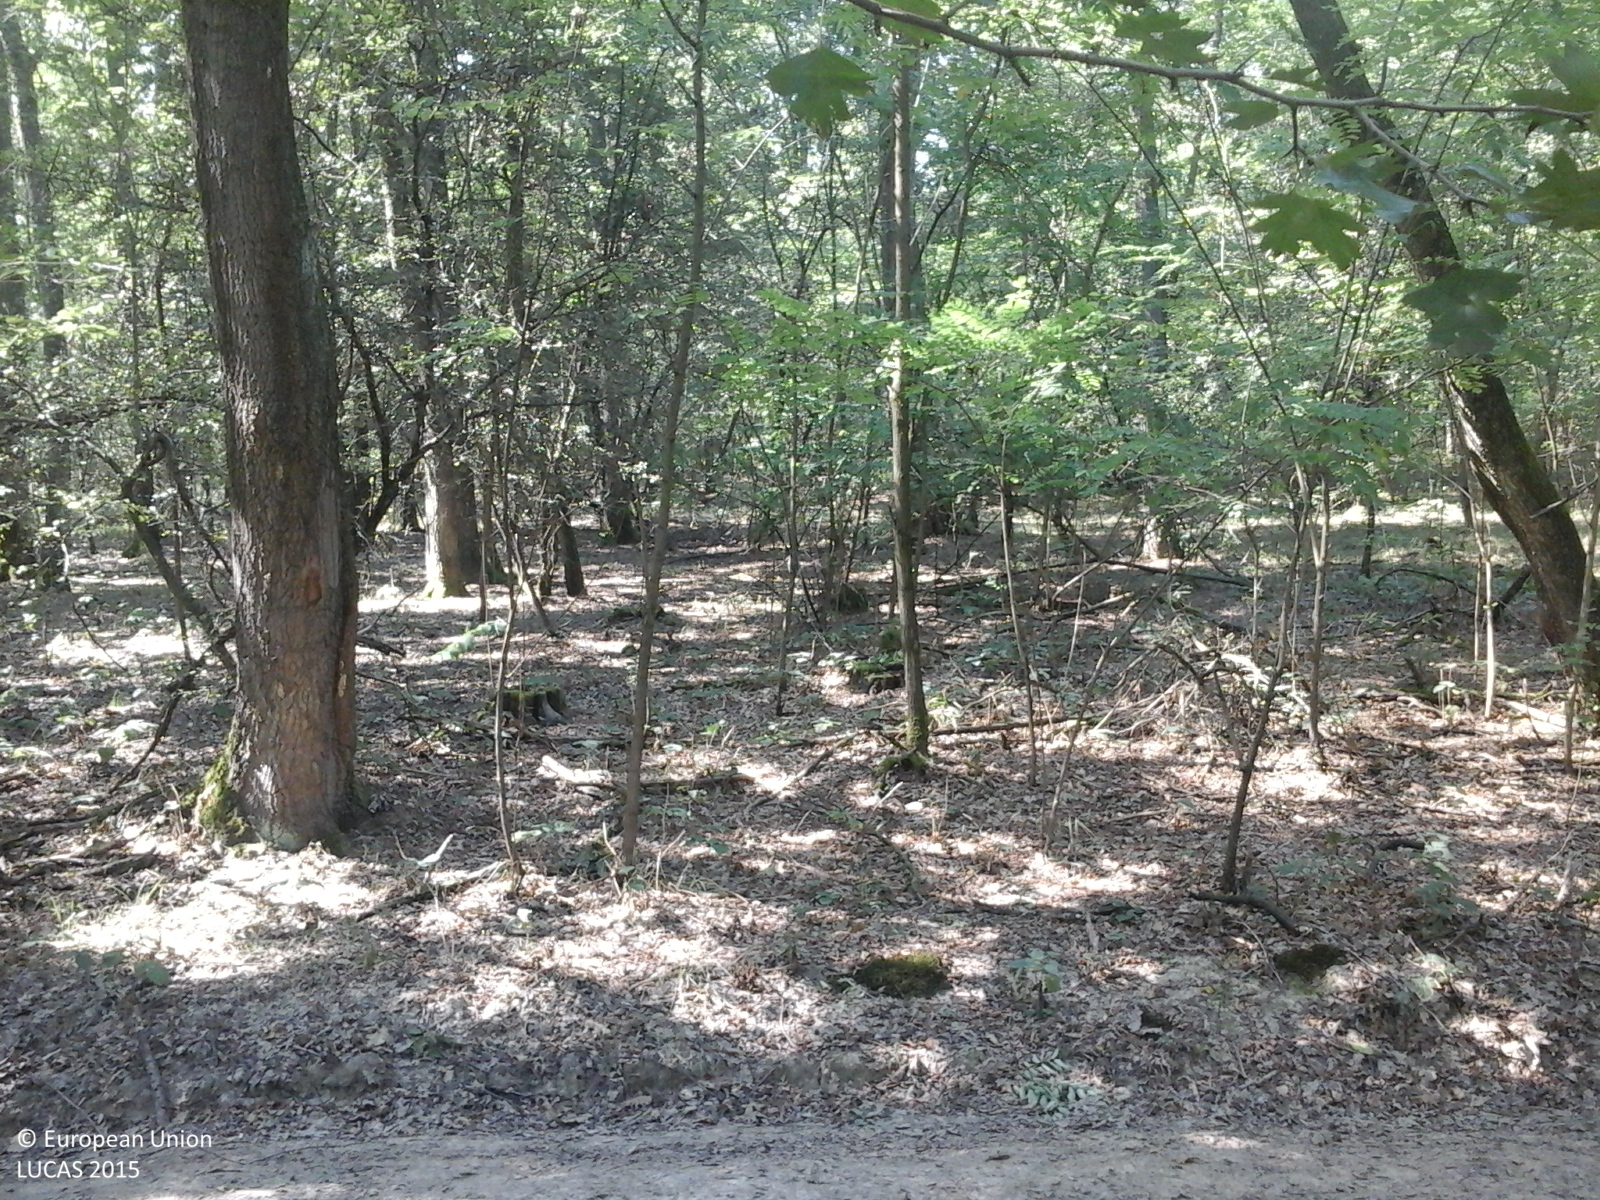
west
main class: Woodland
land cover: Broadleaved woodland
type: acidophilous oak and oak-birch forest
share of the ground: > 75 %
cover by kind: broadleaved forest trees 100 %
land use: Forestry
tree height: > 5 m
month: September
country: RO
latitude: 47.3545
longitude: 22.7293
